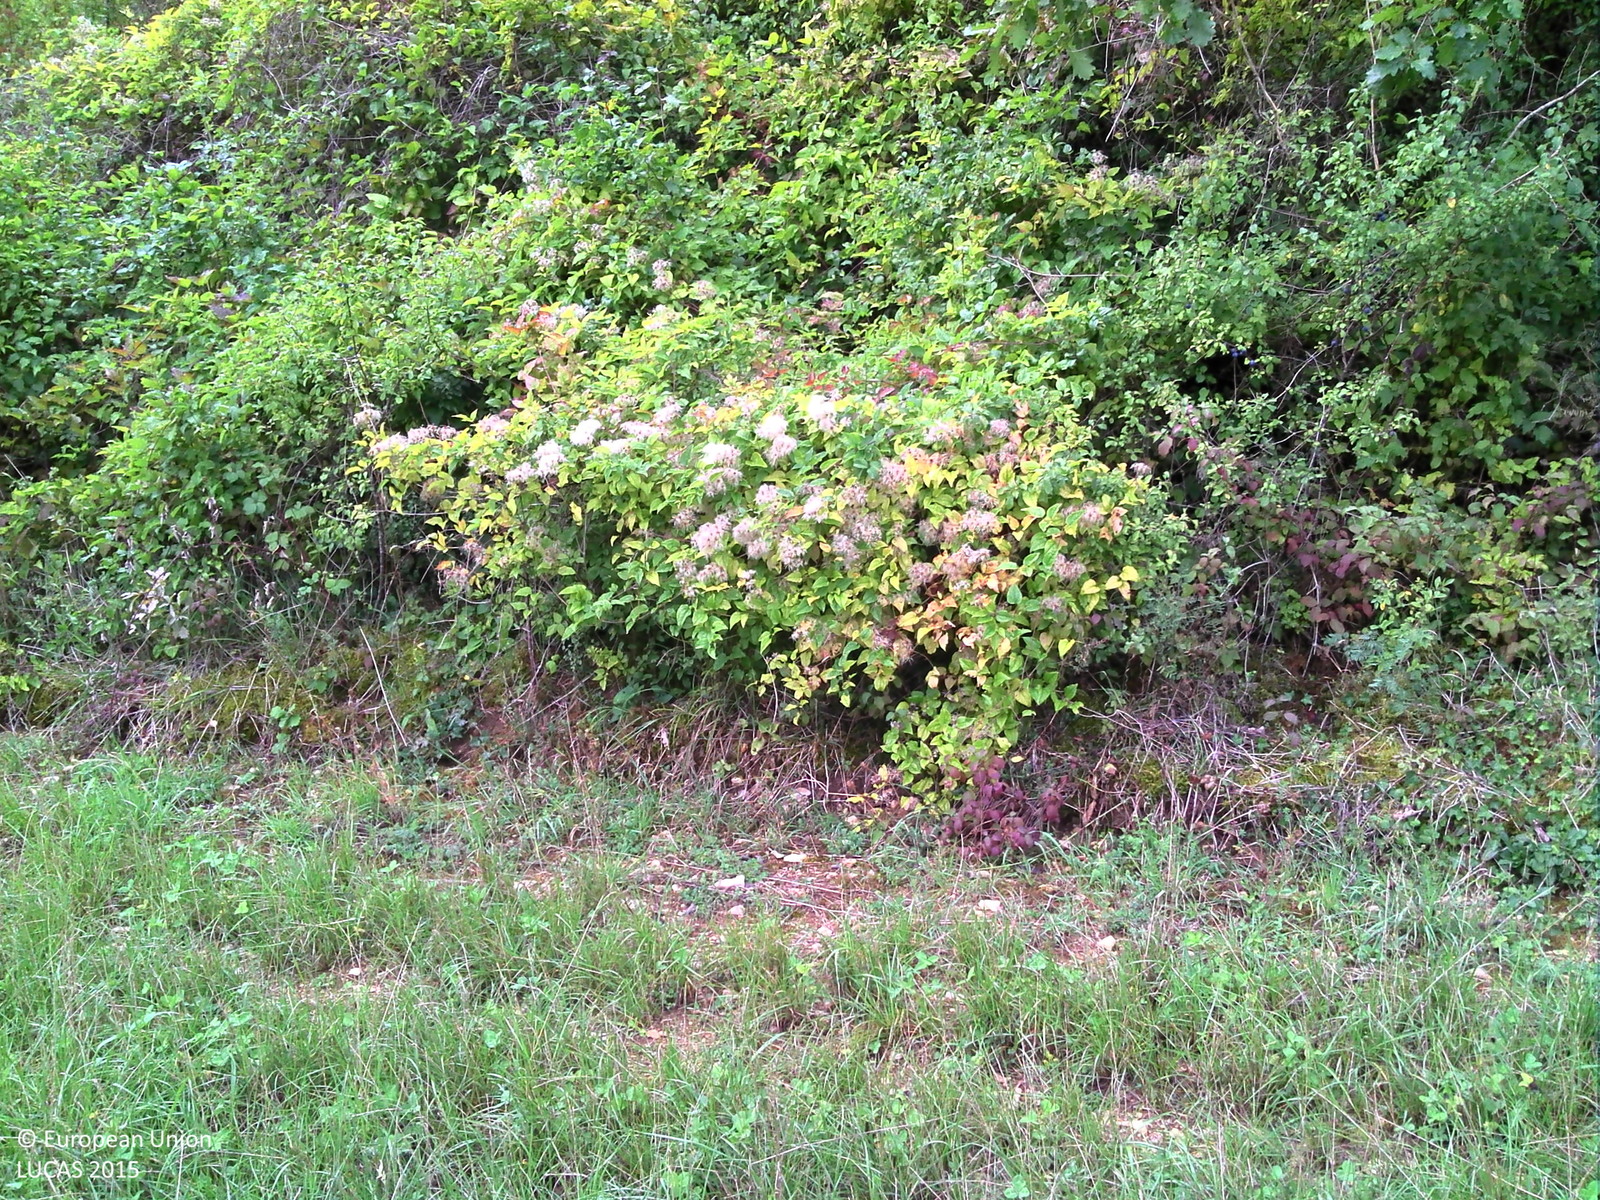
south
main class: Cropland
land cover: Temporary grasslands
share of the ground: > 75 %
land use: Agriculture (excluding fallow land and kitchen gardens)
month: September
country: FR
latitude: 48.1842
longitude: 4.6583
